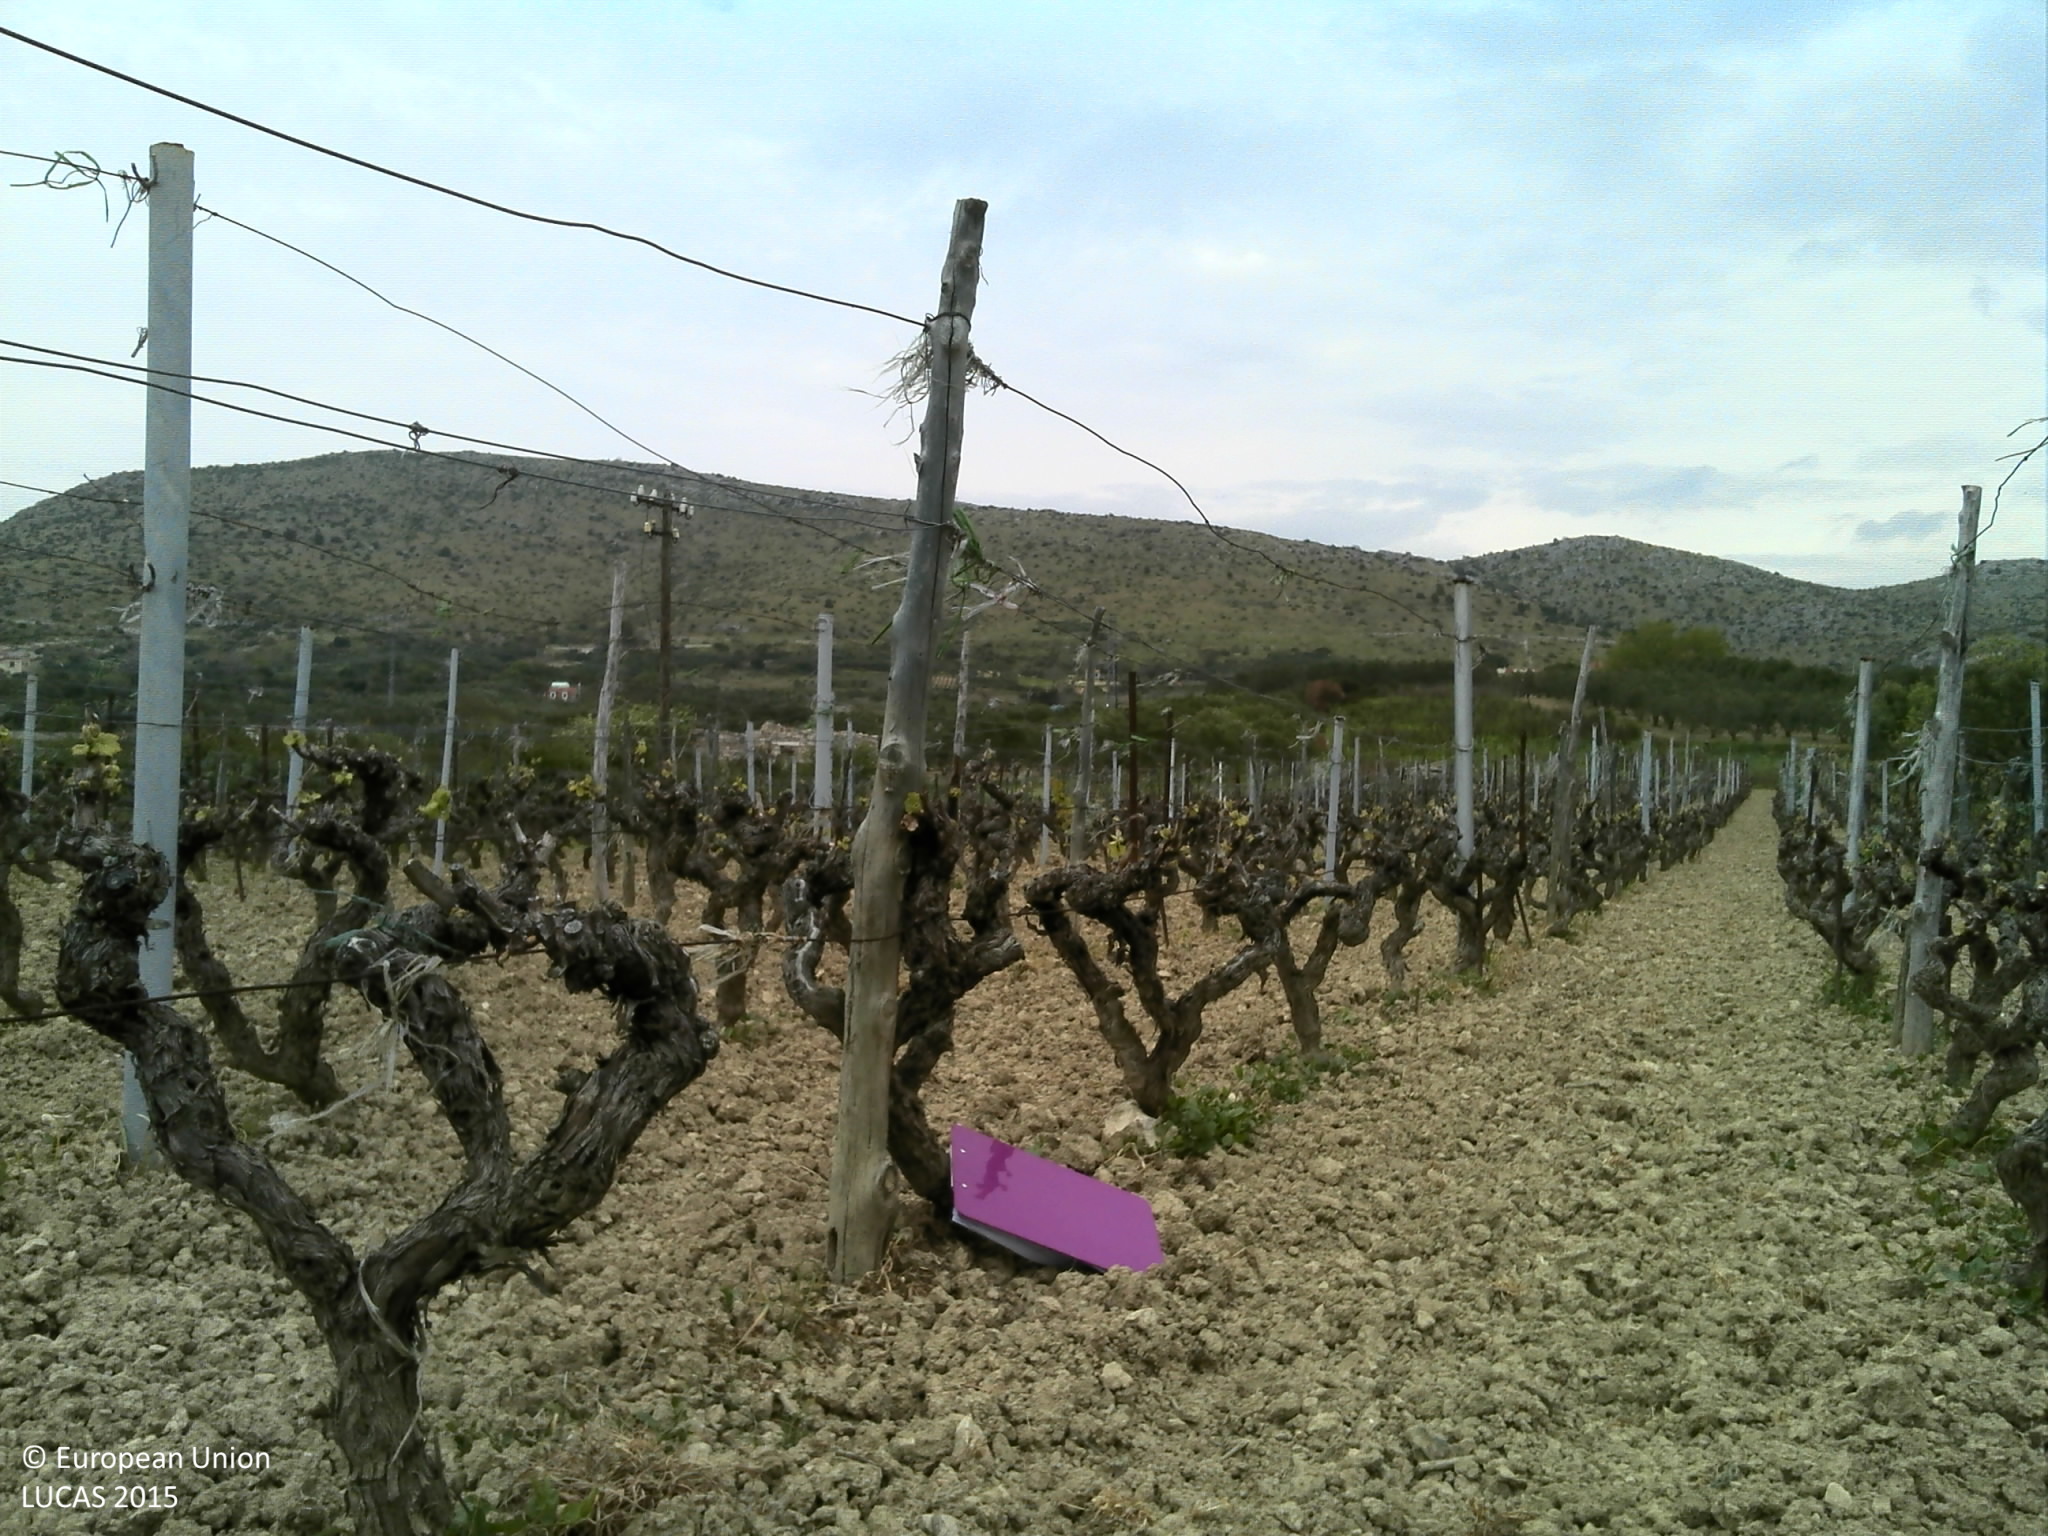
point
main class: Cropland
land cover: Vineyards
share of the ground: > 75 %
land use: Agriculture (excluding fallow land and kitchen gardens)
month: April
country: HR
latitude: 43.6910
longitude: 15.9586
